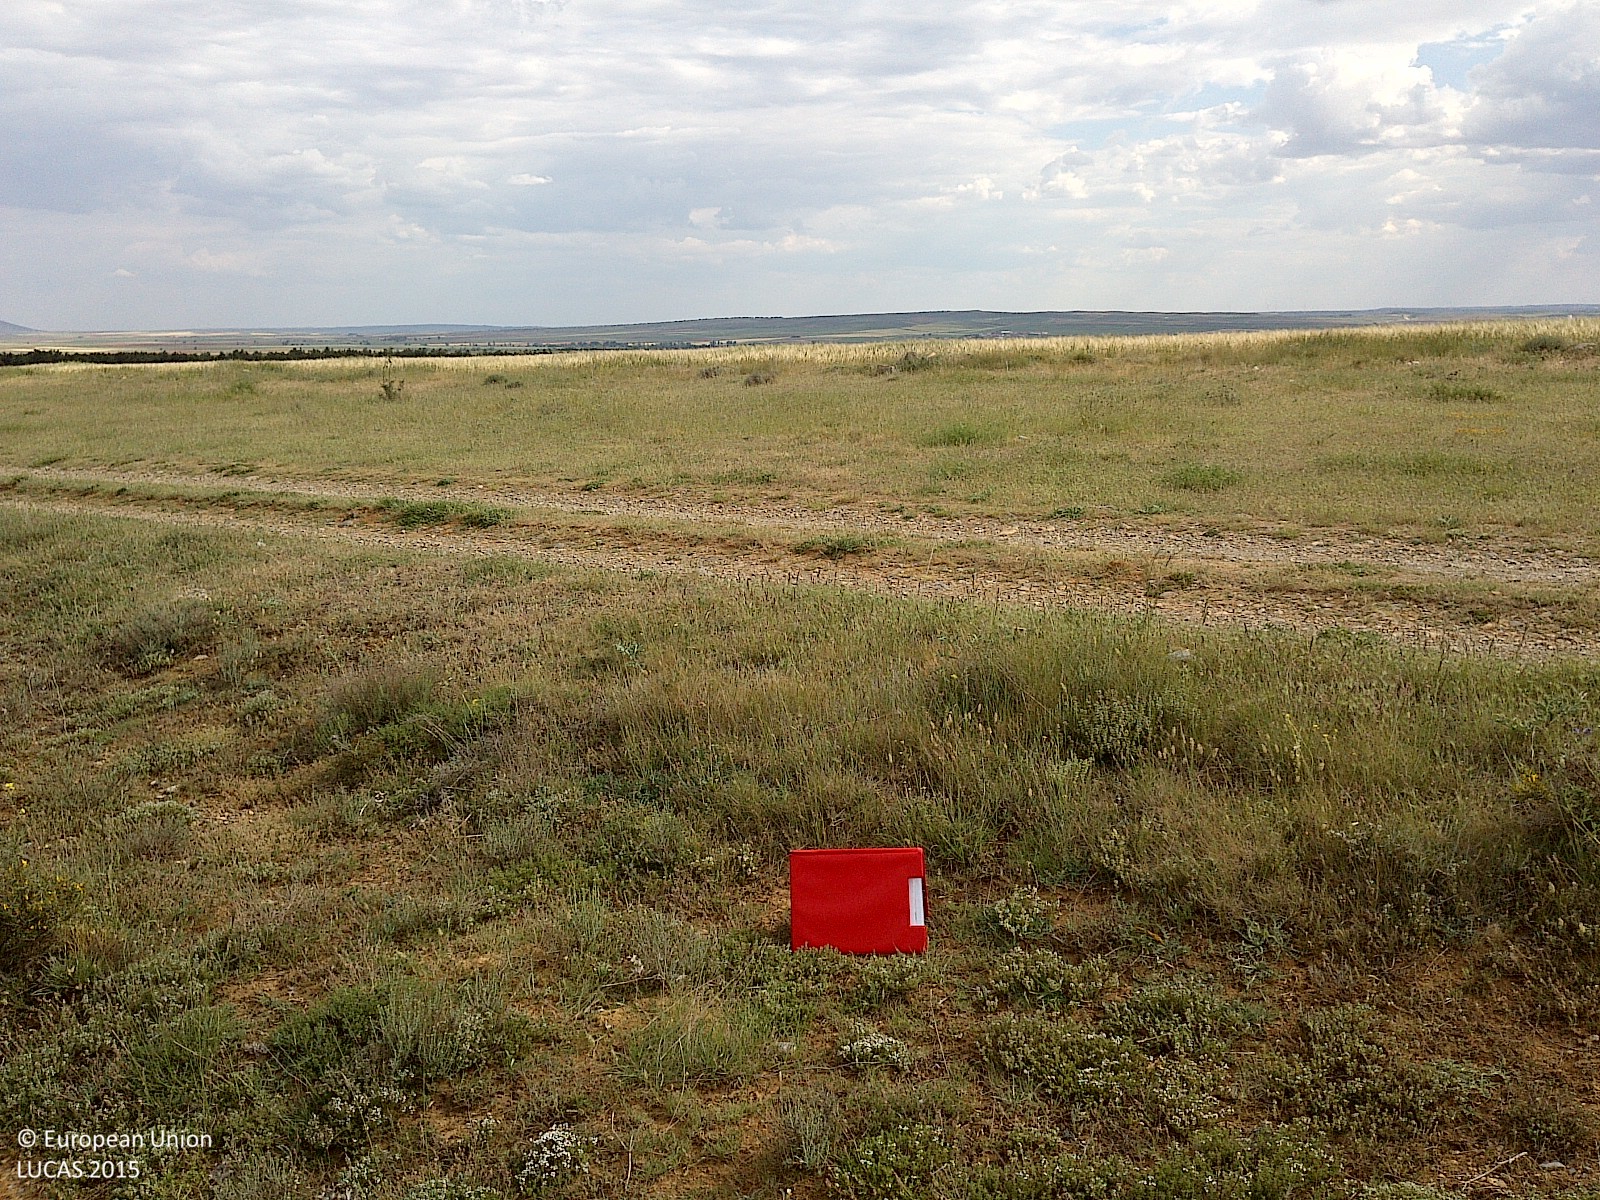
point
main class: Grassland
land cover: Grassland without tree/shrub cover
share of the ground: > 75 %
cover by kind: herbaceous plants 75 %, consolidated bare surface 15 %, shrubs 5 %, lichens and mosses 5 %
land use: Semi-natural and natural areas not in use
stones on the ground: < 10 %
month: June
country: ES
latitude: 41.6968
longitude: -2.1822
